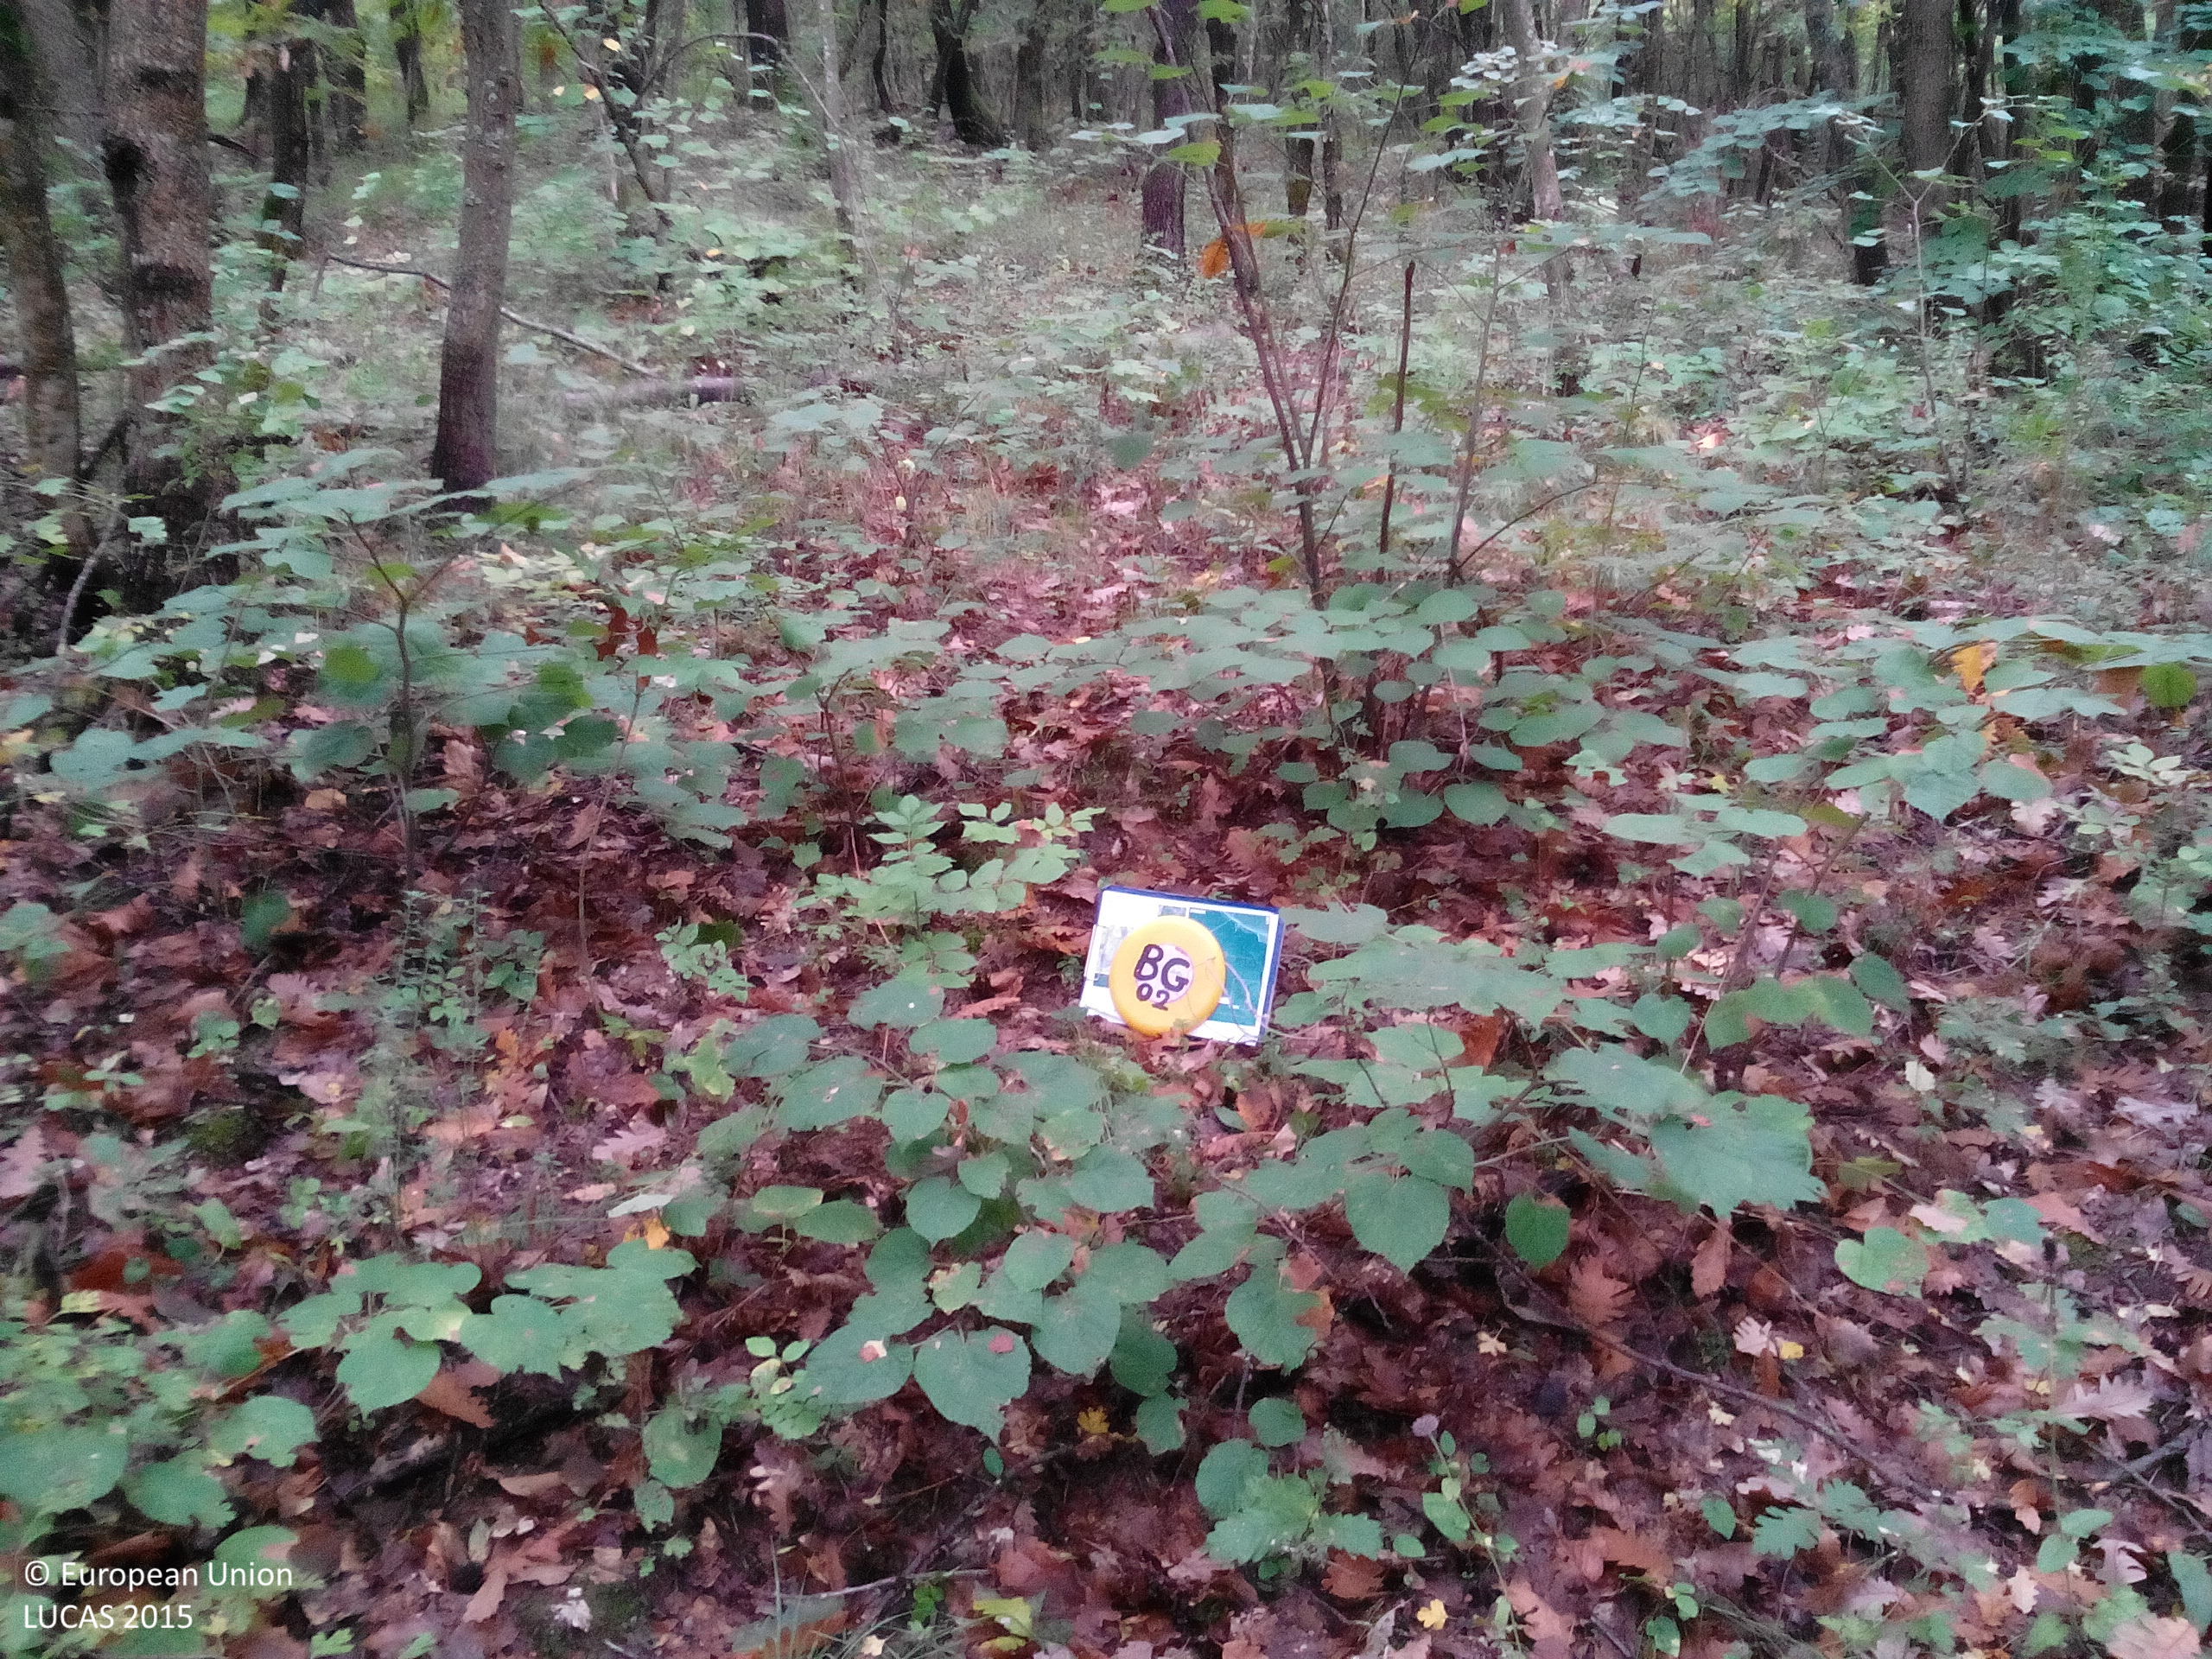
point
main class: Woodland
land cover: Broadleaved woodland
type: mesophytic deciduous forest
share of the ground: > 75 %
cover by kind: broadleaved forest trees 90 %, shrubs 5 %, herbaceous plants 5 %
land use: Forestry
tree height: > 5 m
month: October
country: BG
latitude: 43.1285
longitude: 23.9510
